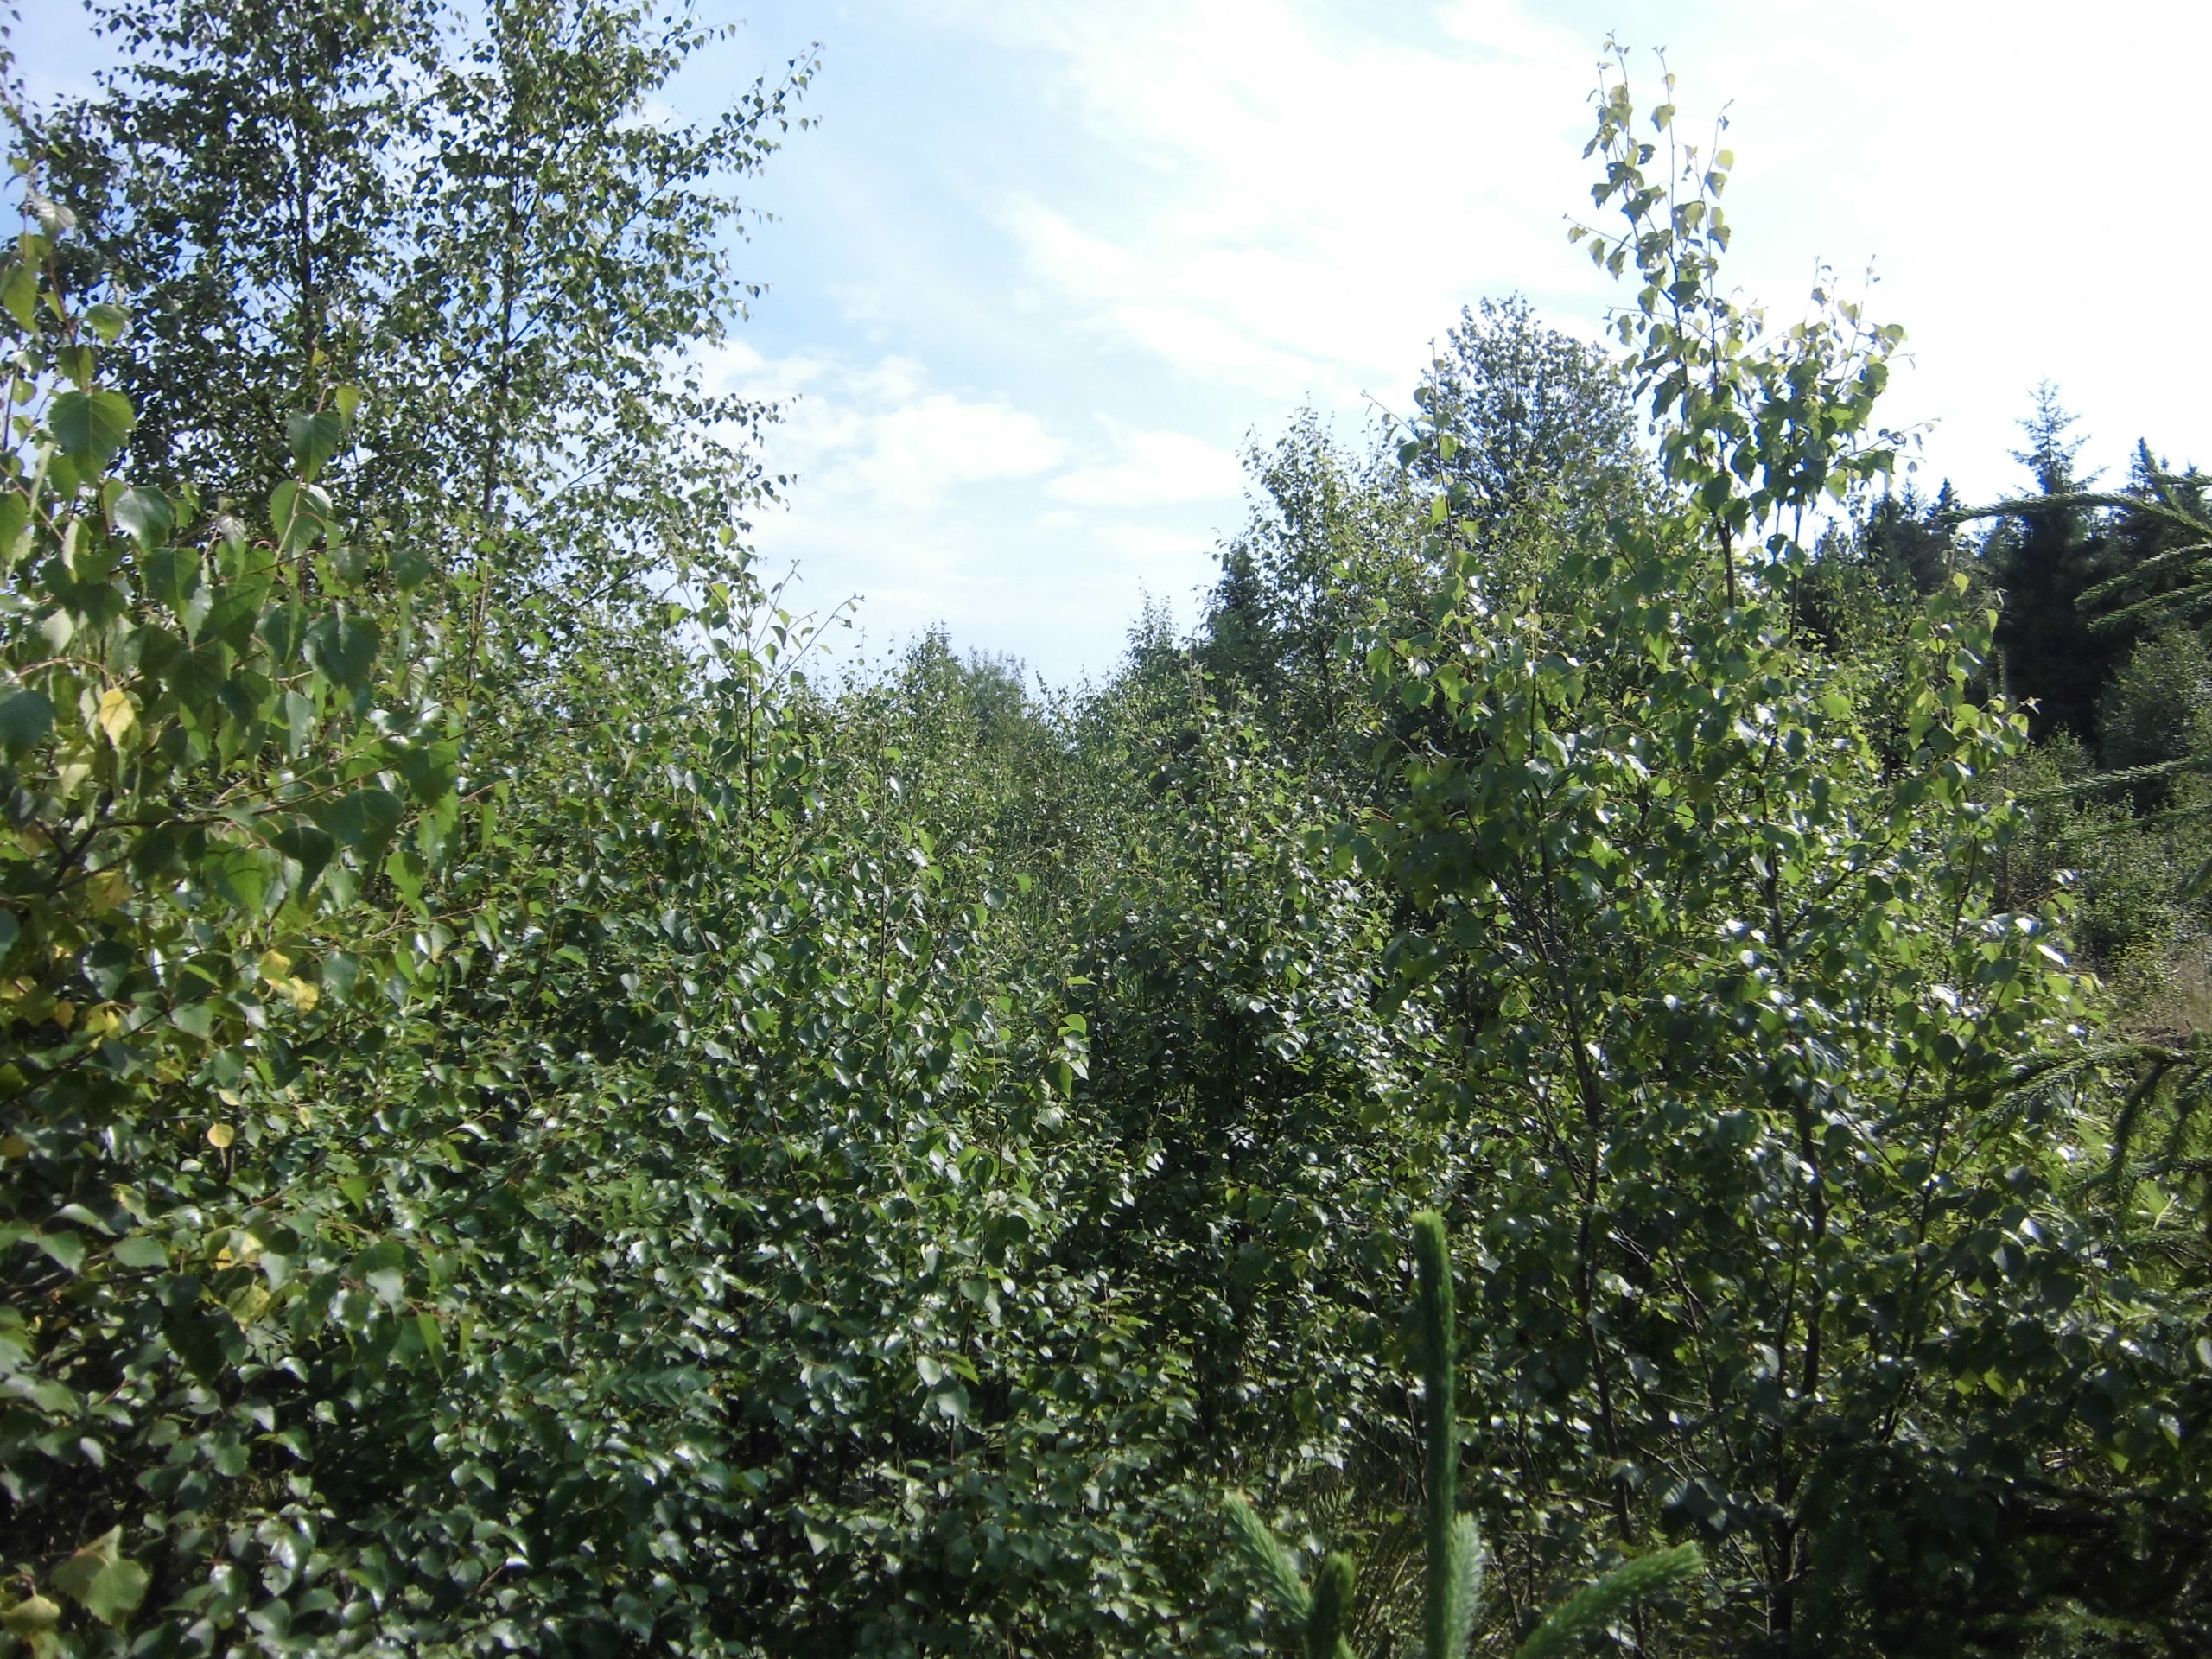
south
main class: Woodland
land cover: Spruce dominated mixed woodland
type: boreal forest
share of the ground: > 75 %
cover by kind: broadleaved forest trees 45 %, coniferous forest trees 30 %, herbaceous plants 15 %, shrubs 5 %, lichens and mosses 5 %
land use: Forestry
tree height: < 5 m
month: July
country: SE
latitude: 57.3493
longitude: 14.5662
